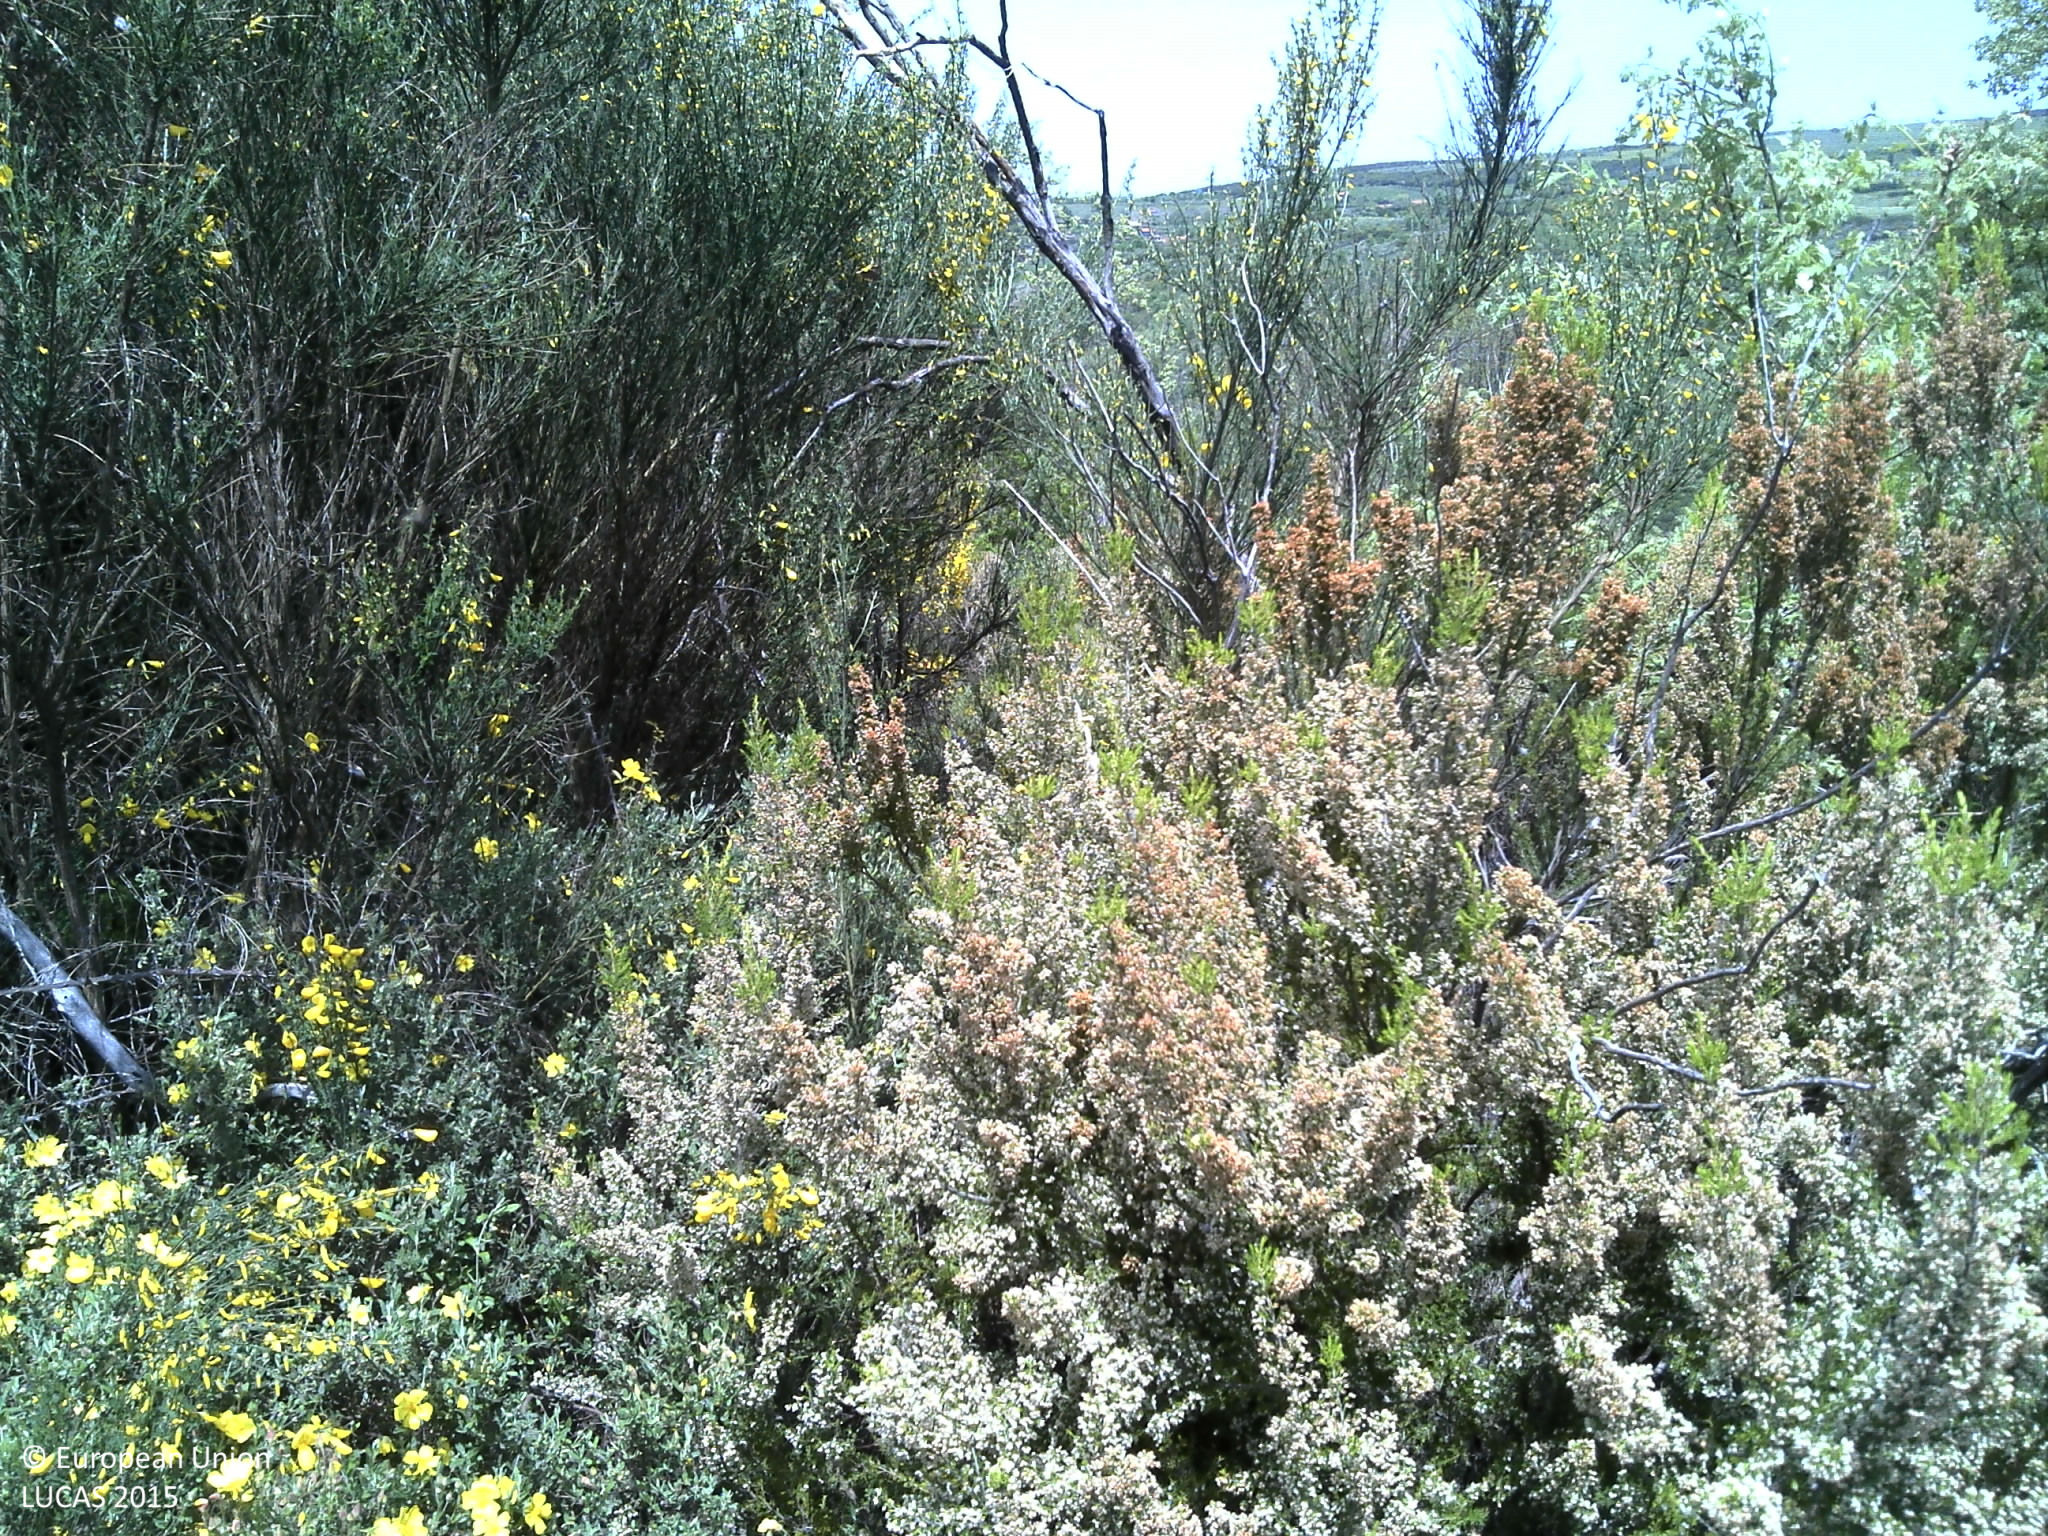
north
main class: Shrubland
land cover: Shrubland with sparse tree cover
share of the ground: > 75 %
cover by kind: shrubs 85 %, herbaceous plants 10 %, broadleaved forest trees 5 %
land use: Forestry
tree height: < 5 m
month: May
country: PT
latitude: 41.9338
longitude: -7.0426
